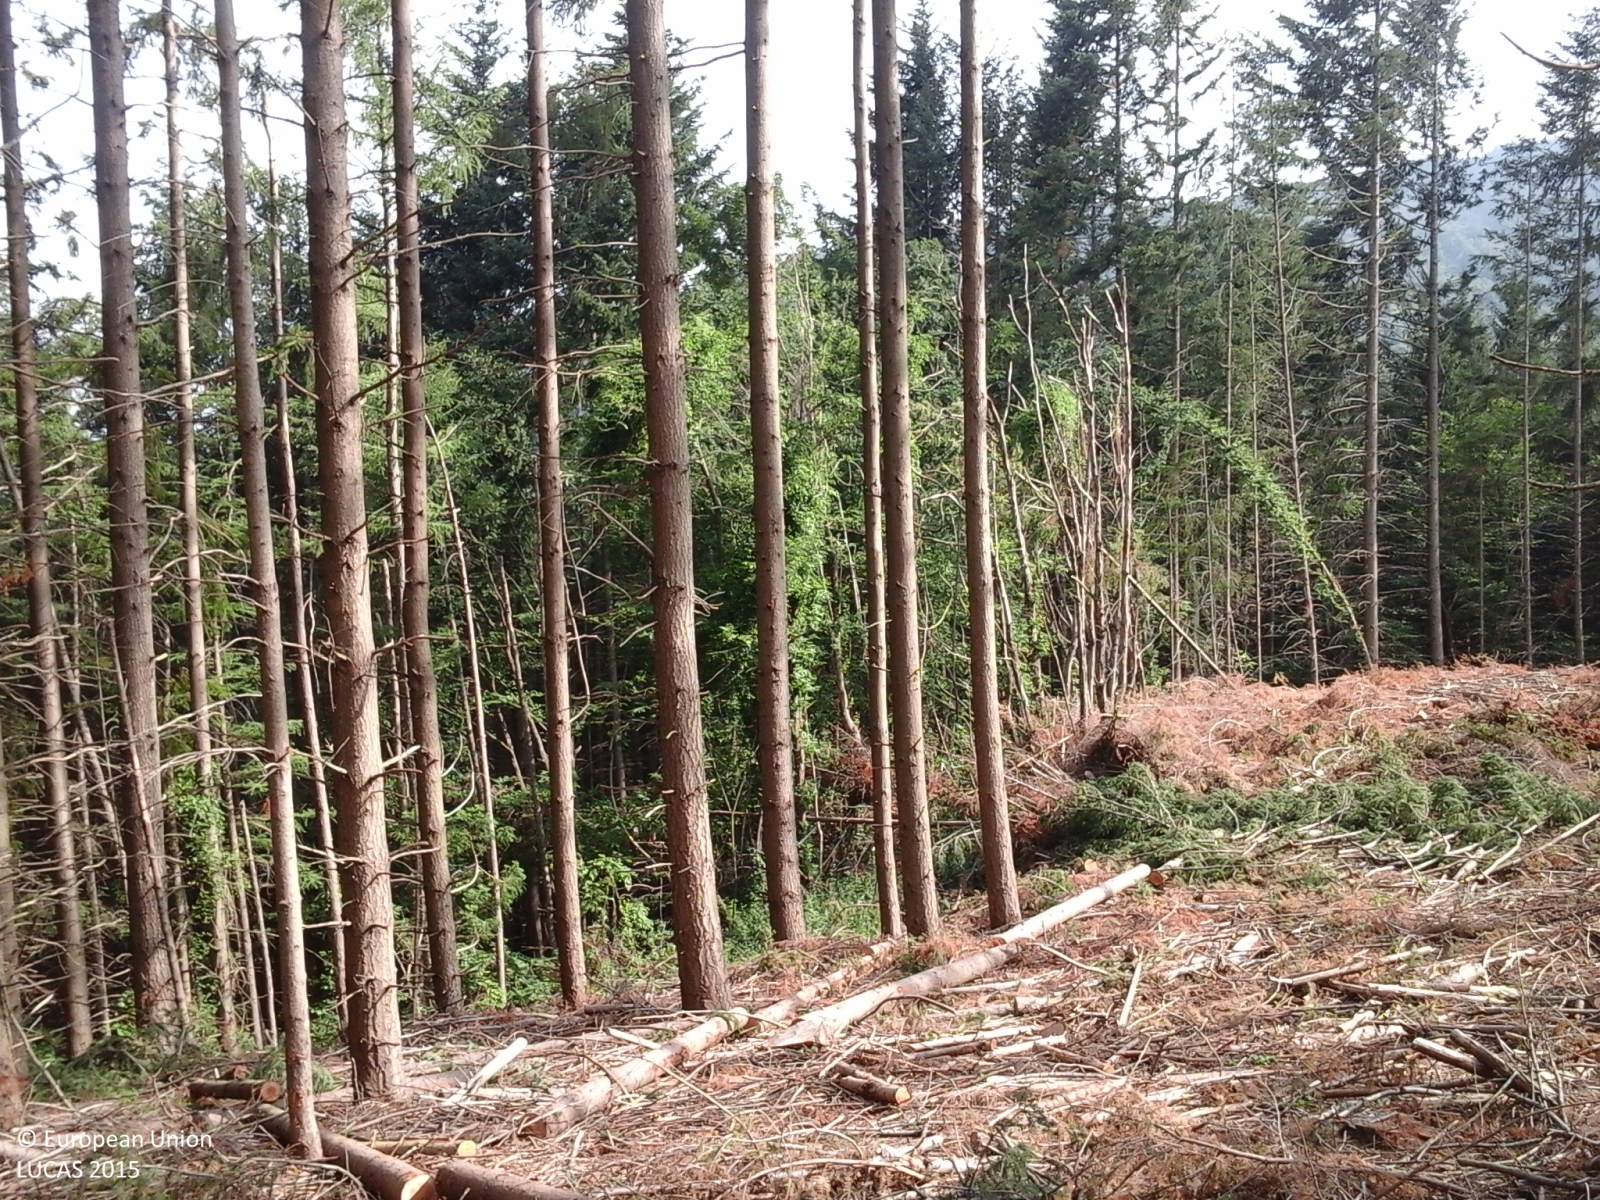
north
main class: Woodland
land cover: Other coniferous woodland
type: coniferous forest of the mediterranean region
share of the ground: > 75 %
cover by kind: coniferous forest trees 80 %, broadleaved forest trees 20 %
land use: Forestry
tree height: > 5 m
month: June
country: IT
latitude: 43.8507
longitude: 11.6255
